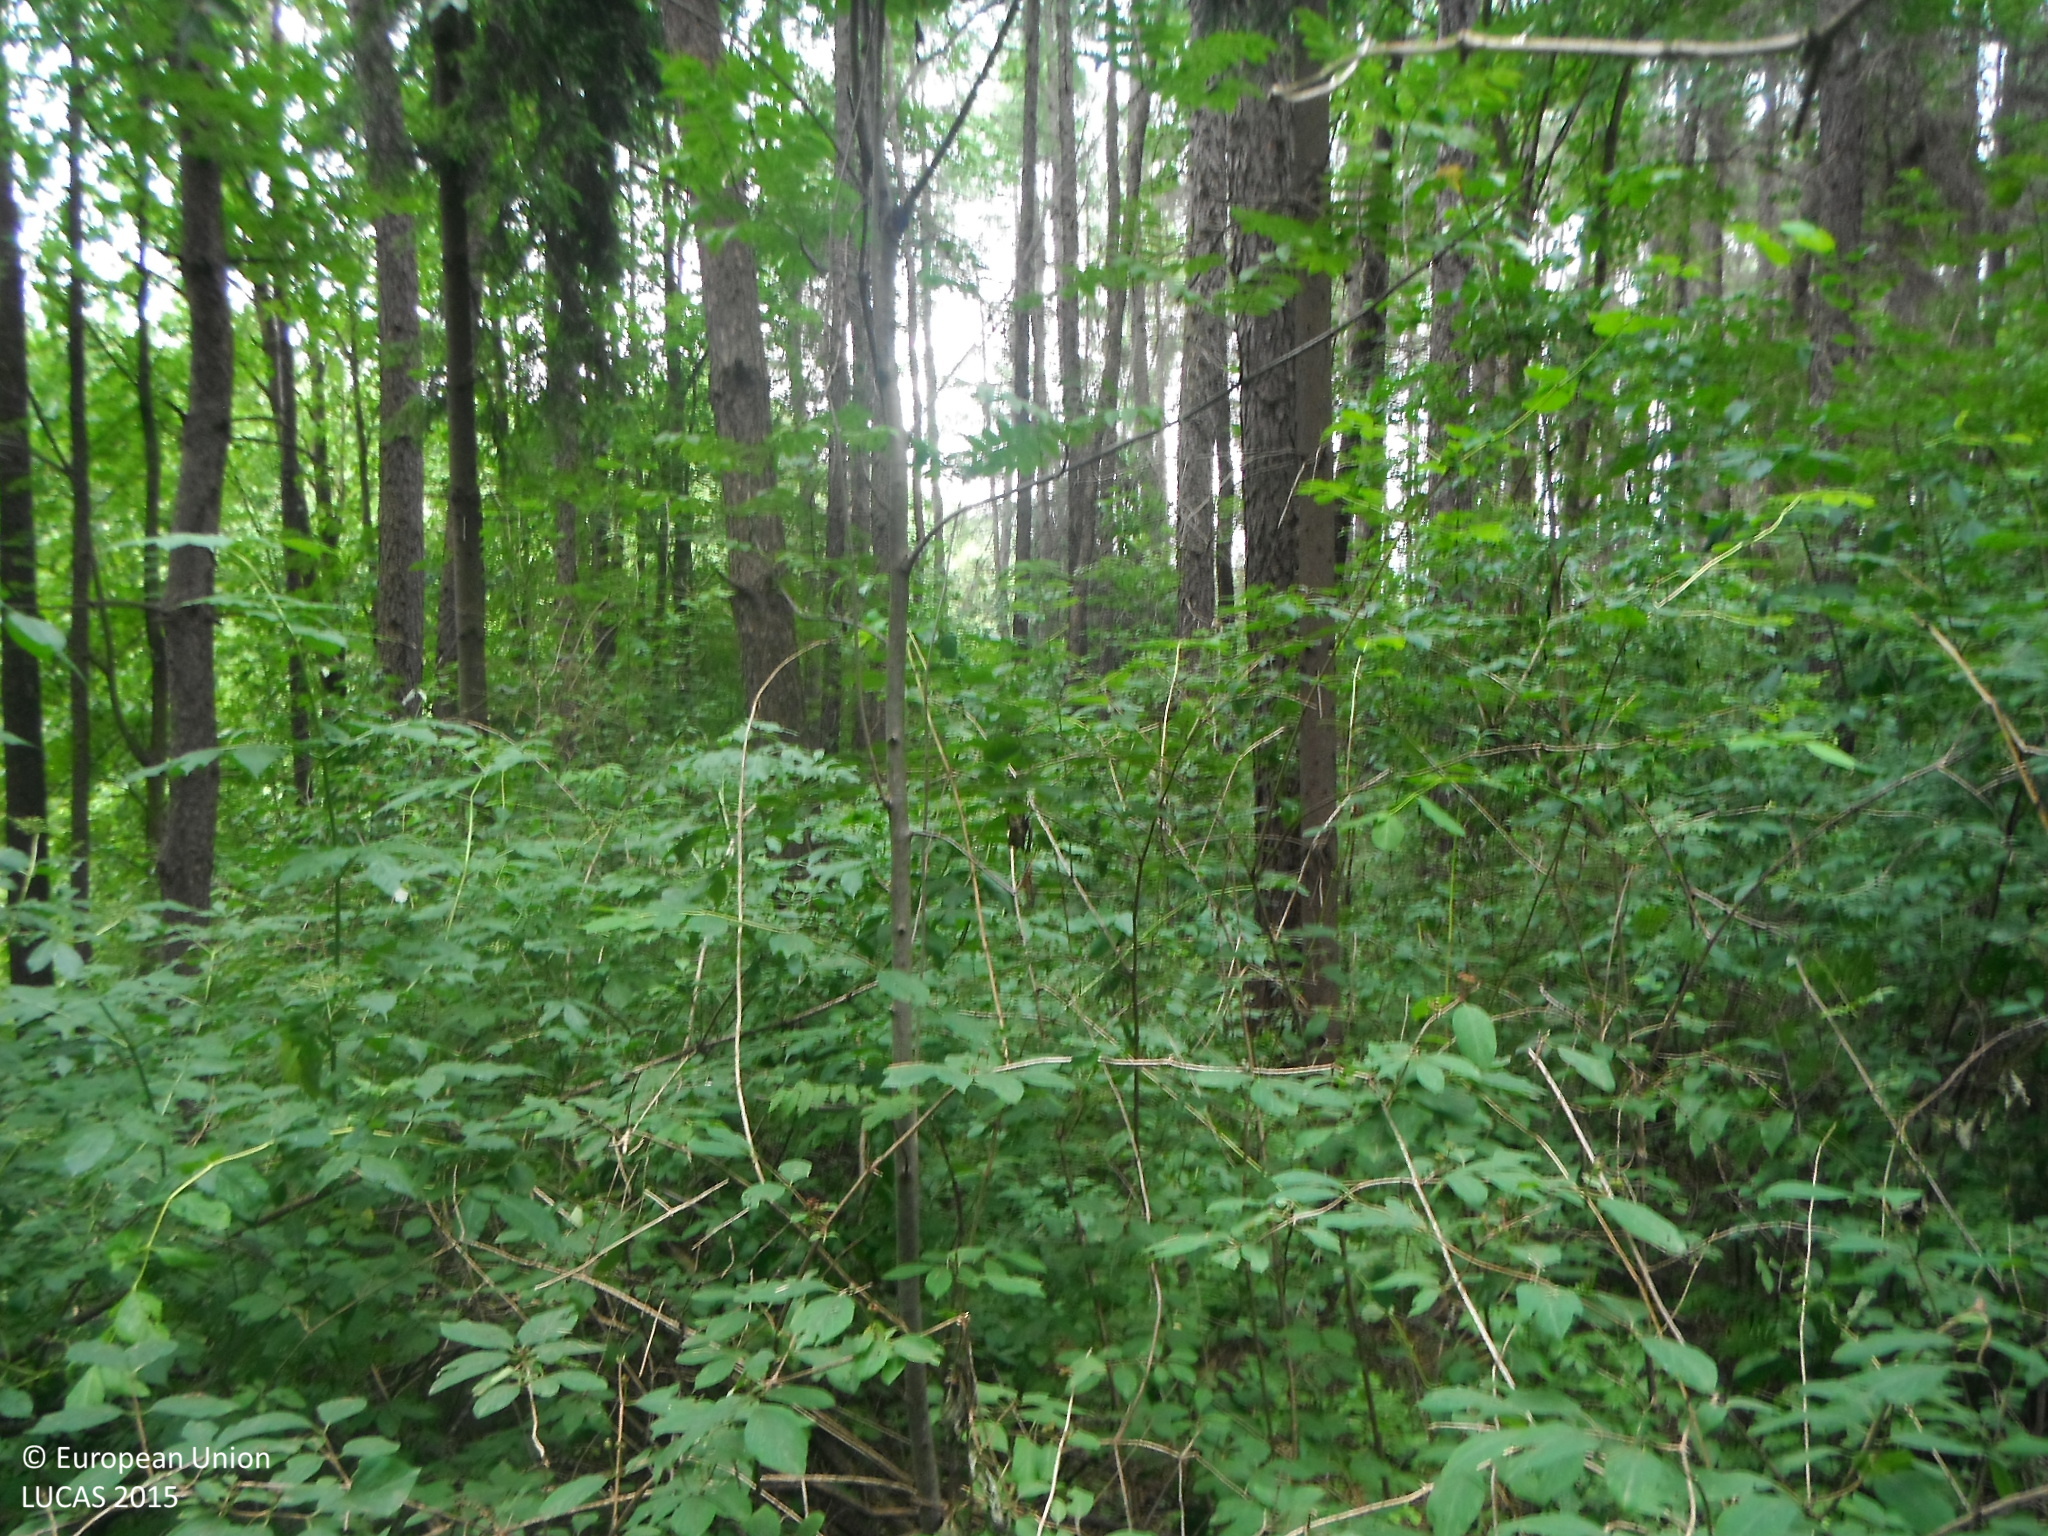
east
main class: Woodland
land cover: Other mixed woodland
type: hemiboreal forest and nemoral coniferous forest and mixed broadleaved-coniferous forest
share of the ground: > 75 %
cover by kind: coniferous forest trees 65 %, broadleaved forest trees 35 %
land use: Amenities, museums, leisure
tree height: > 5 m
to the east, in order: Other mixed woodland; Grassland with sparse tree/shrub cover; Other mixed woodland
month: July
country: SK
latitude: 49.0270
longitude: 20.3048
